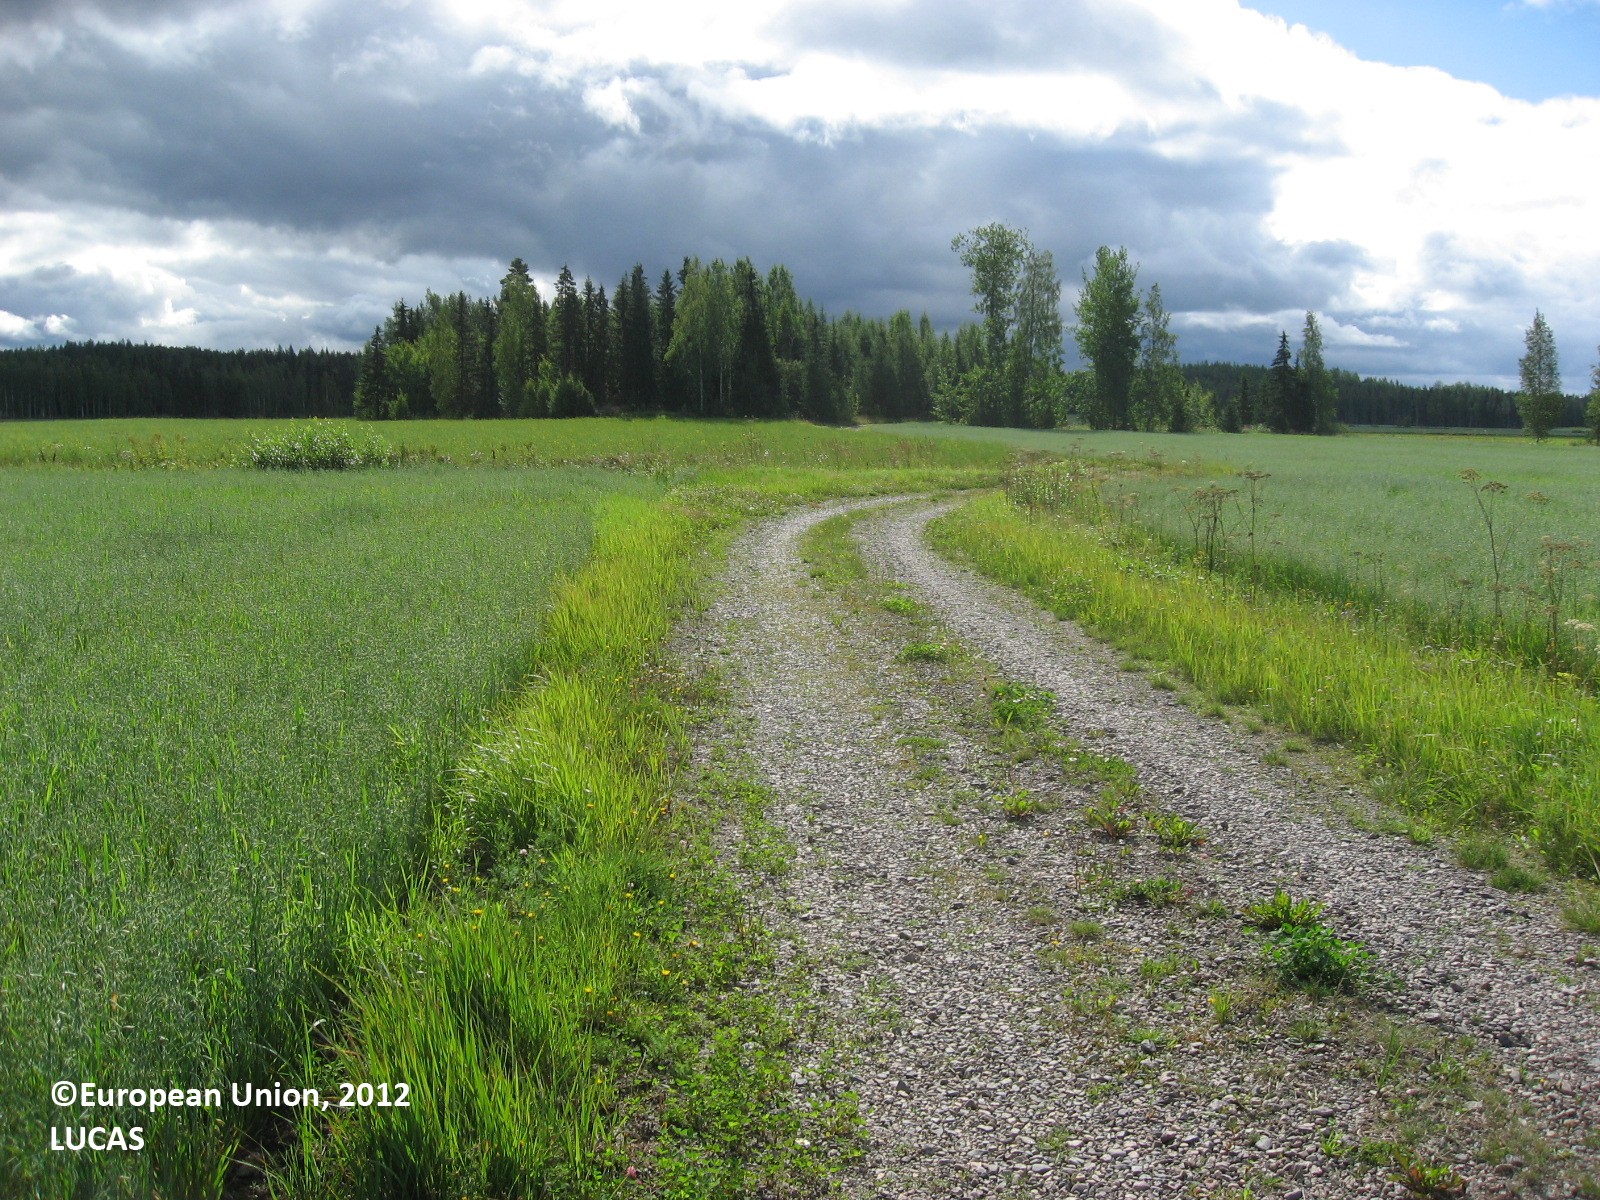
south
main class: Cropland
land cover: Oats
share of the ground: > 75 %
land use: Agriculture (excluding fallow land and kitchen gardens)
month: August
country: FI
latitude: 60.6445
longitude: 25.4702
